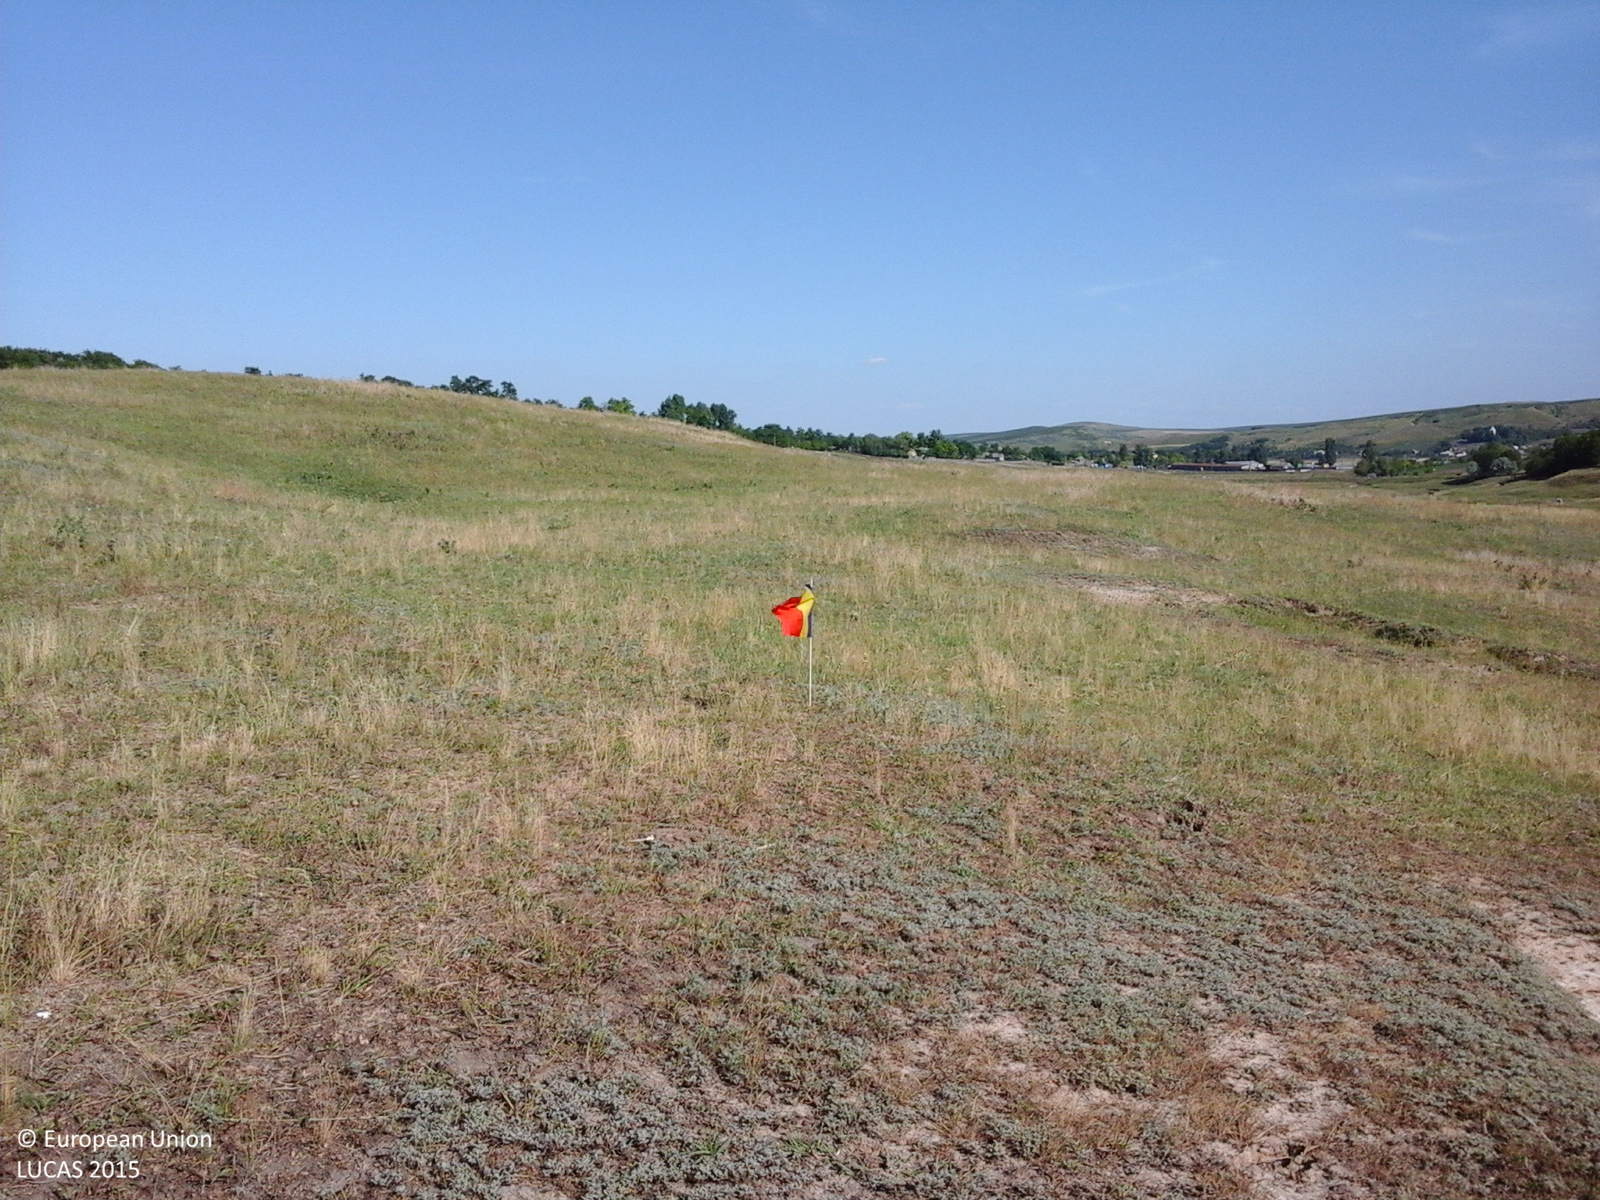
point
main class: Grassland
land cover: Grassland without tree/shrub cover
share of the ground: > 75 %
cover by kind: herbaceous plants 100 %
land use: Agriculture (excluding fallow land and kitchen gardens)
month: June
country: RO
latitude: 47.4976
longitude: 27.1112
